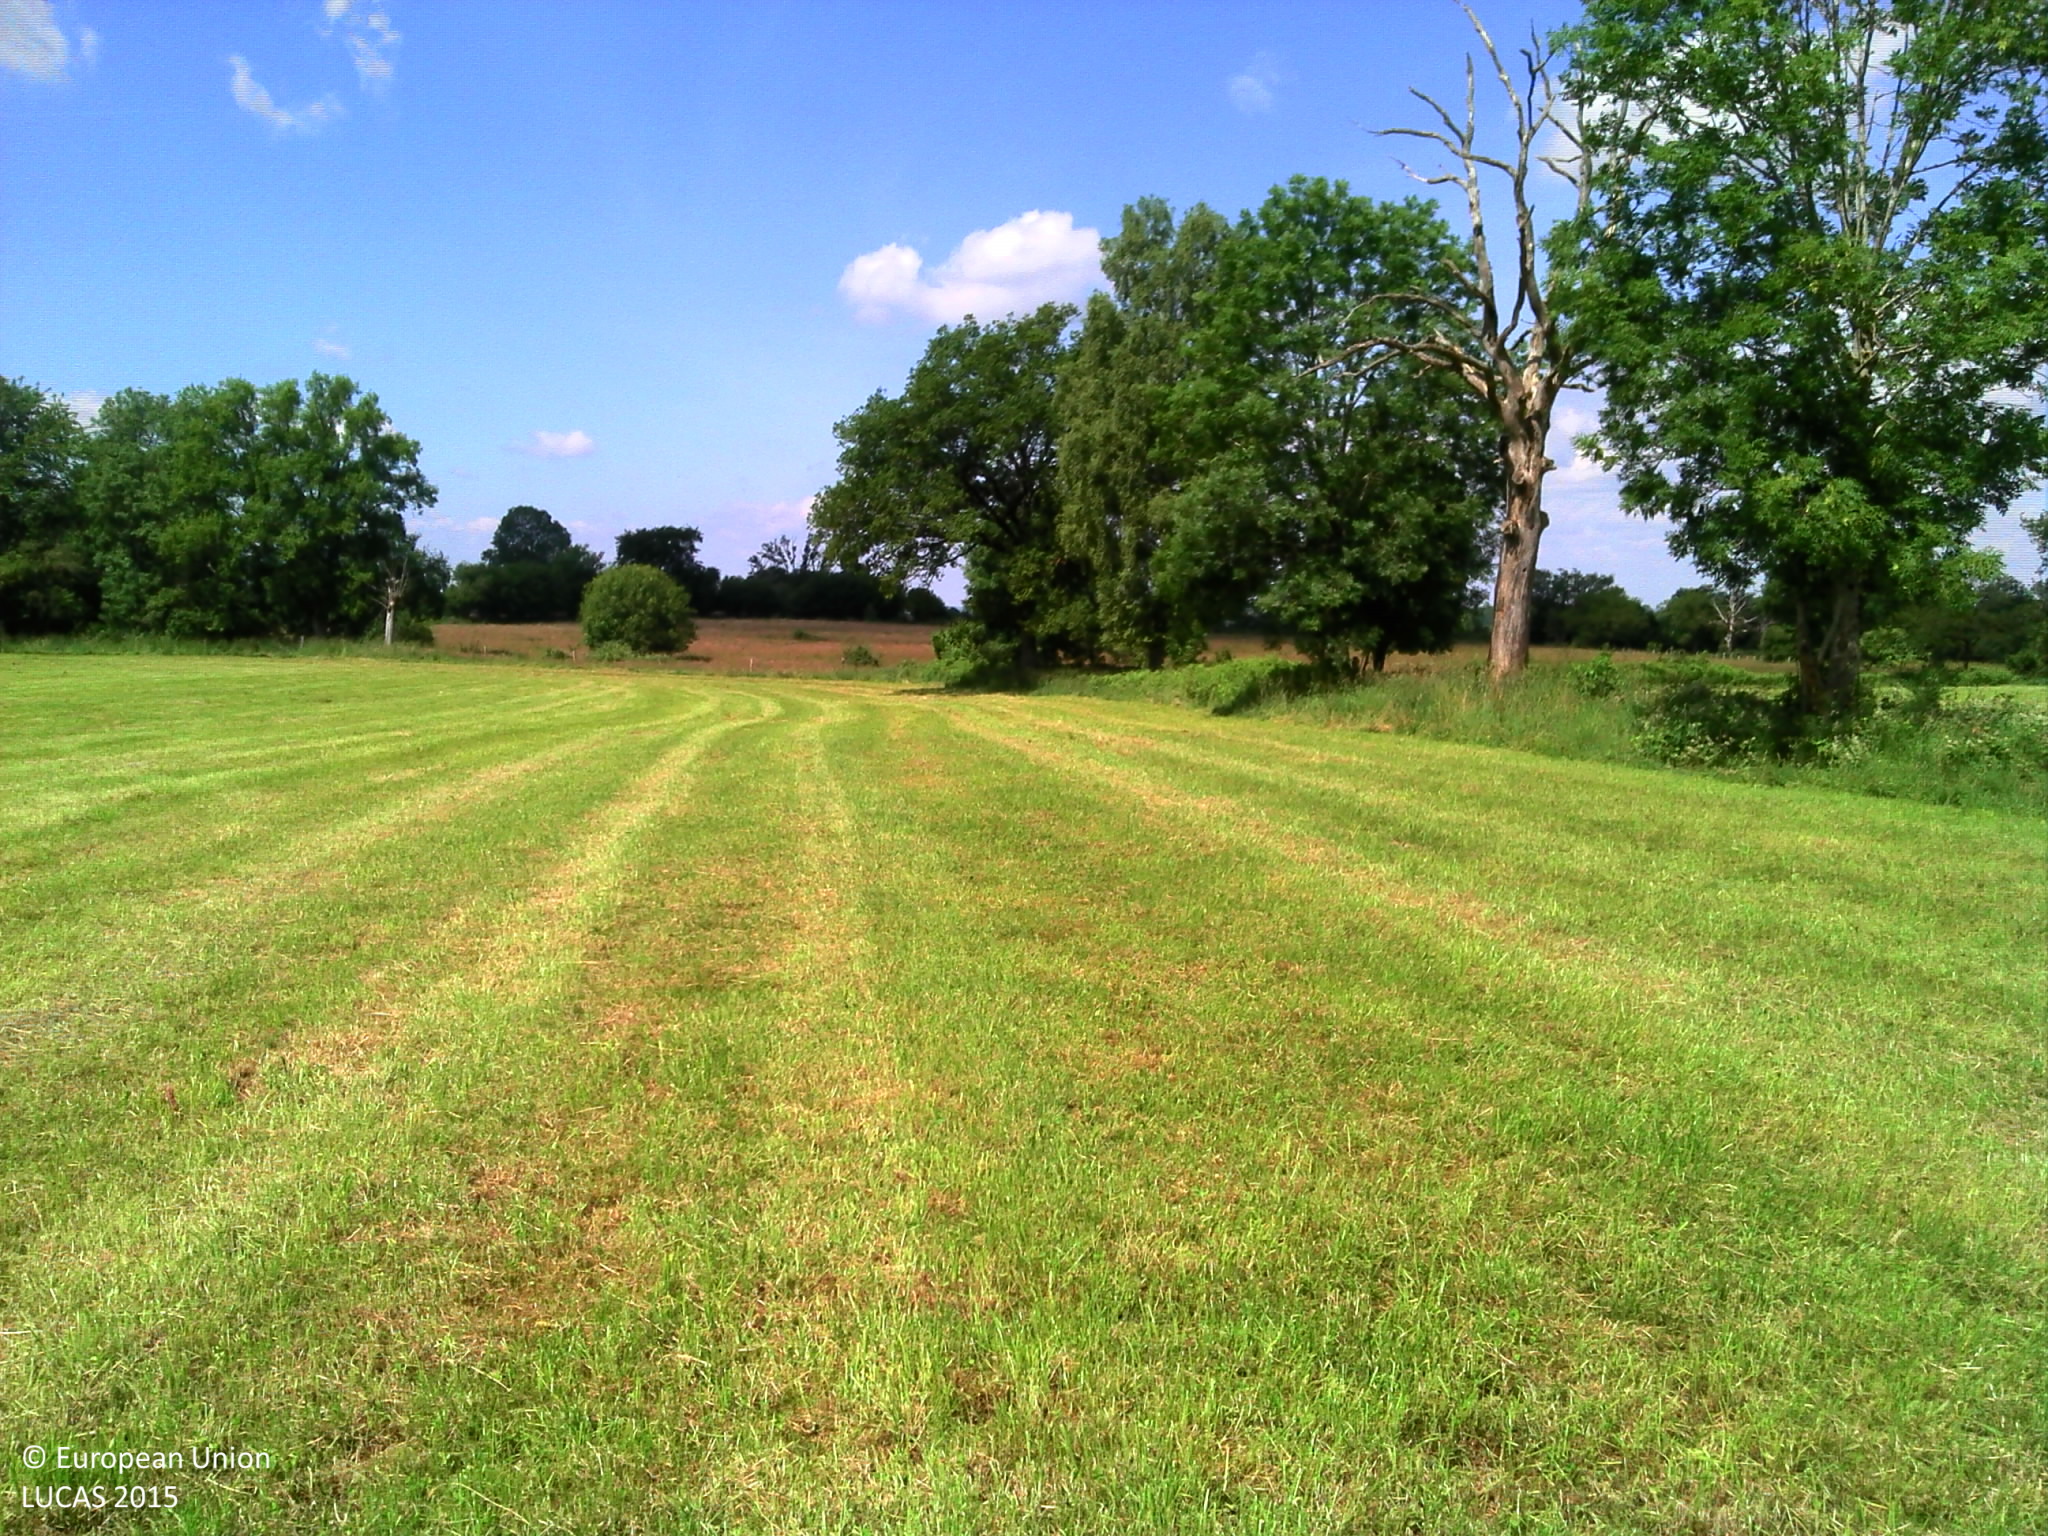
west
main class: Grassland
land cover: Grassland without tree/shrub cover
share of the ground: > 75 %
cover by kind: herbaceous plants 100 %
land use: Agriculture (excluding fallow land and kitchen gardens)
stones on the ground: < 10 %
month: June
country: FR
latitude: 45.2799
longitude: 2.3371
